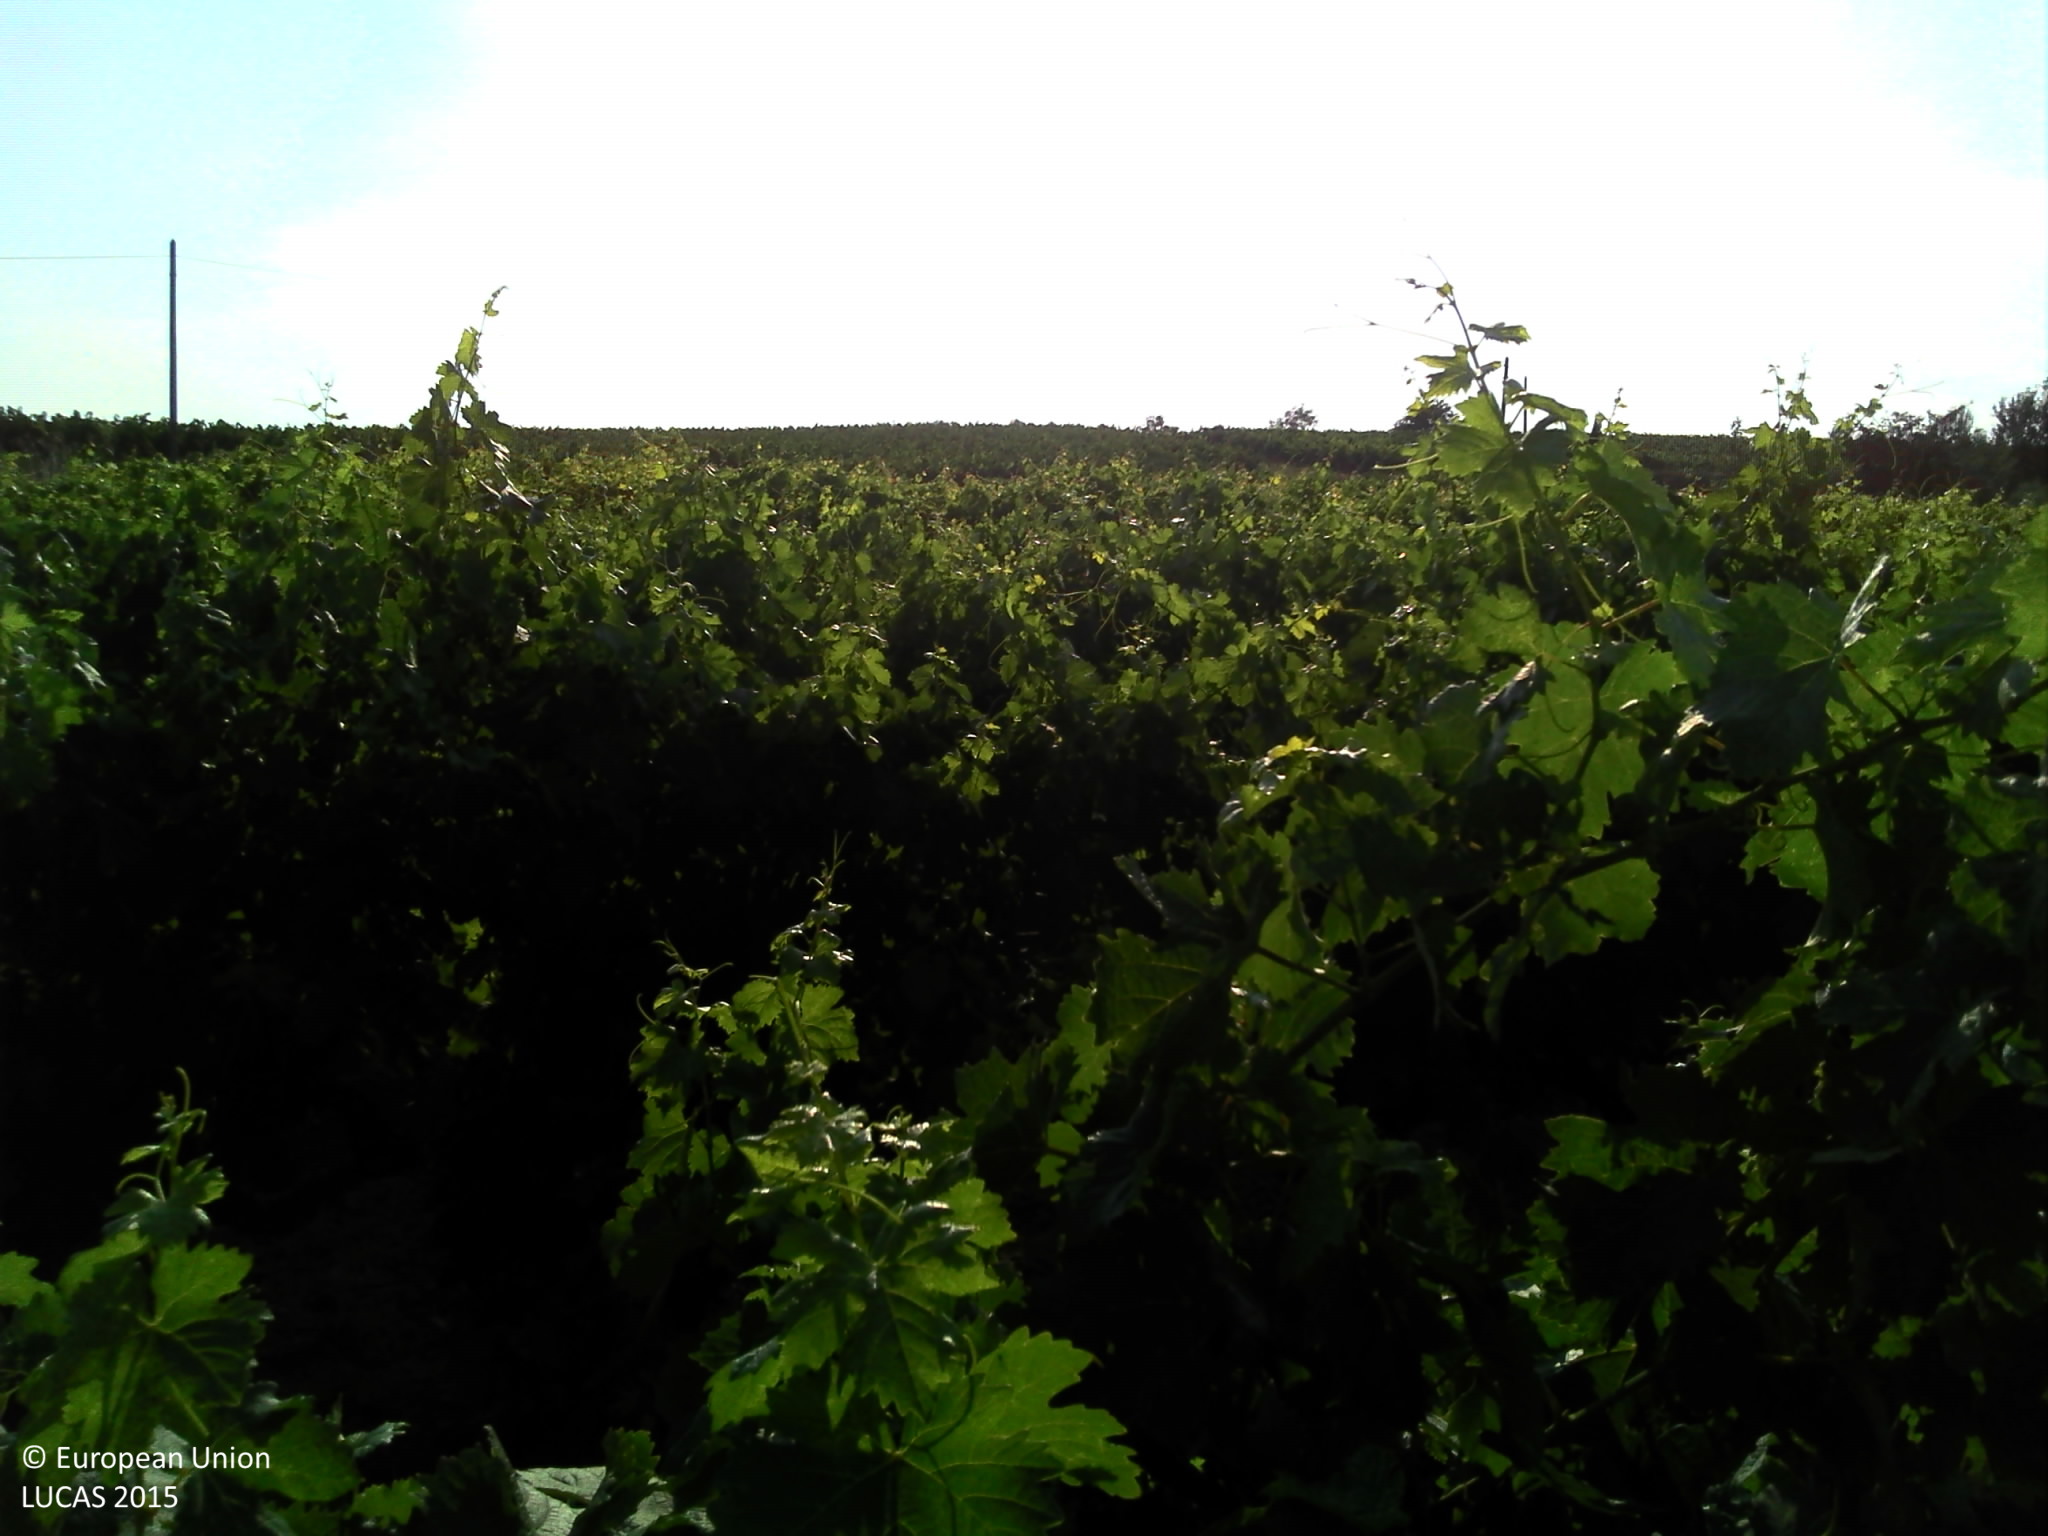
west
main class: Cropland
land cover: Vineyards
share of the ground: 25 - 50 %
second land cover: Other bare soil
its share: > 75 %
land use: Agriculture (excluding fallow land and kitchen gardens)
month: July
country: FR
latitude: 43.7493
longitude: 5.5506
